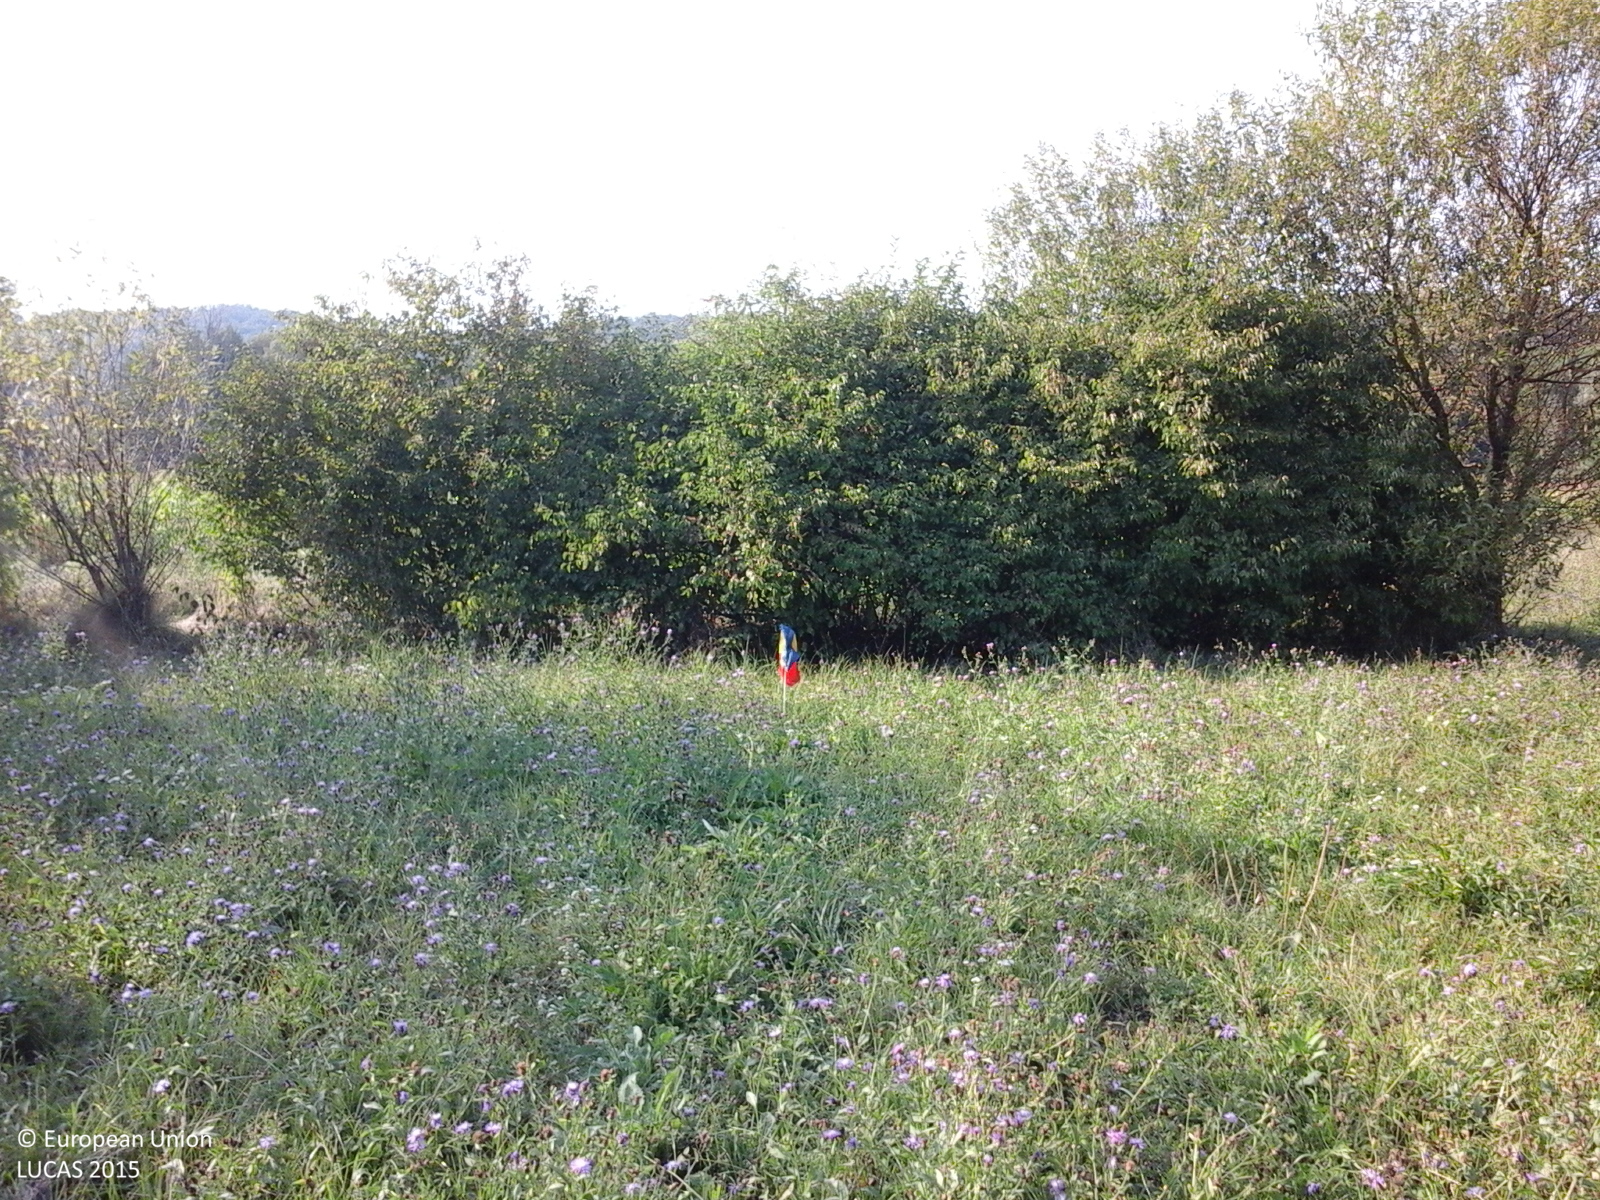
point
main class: Cropland
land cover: Other leguminous and mixtures for fodder
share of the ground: > 75 %
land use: Agriculture (excluding fallow land and kitchen gardens)
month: August
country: RO
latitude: 46.0851
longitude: 22.0568
